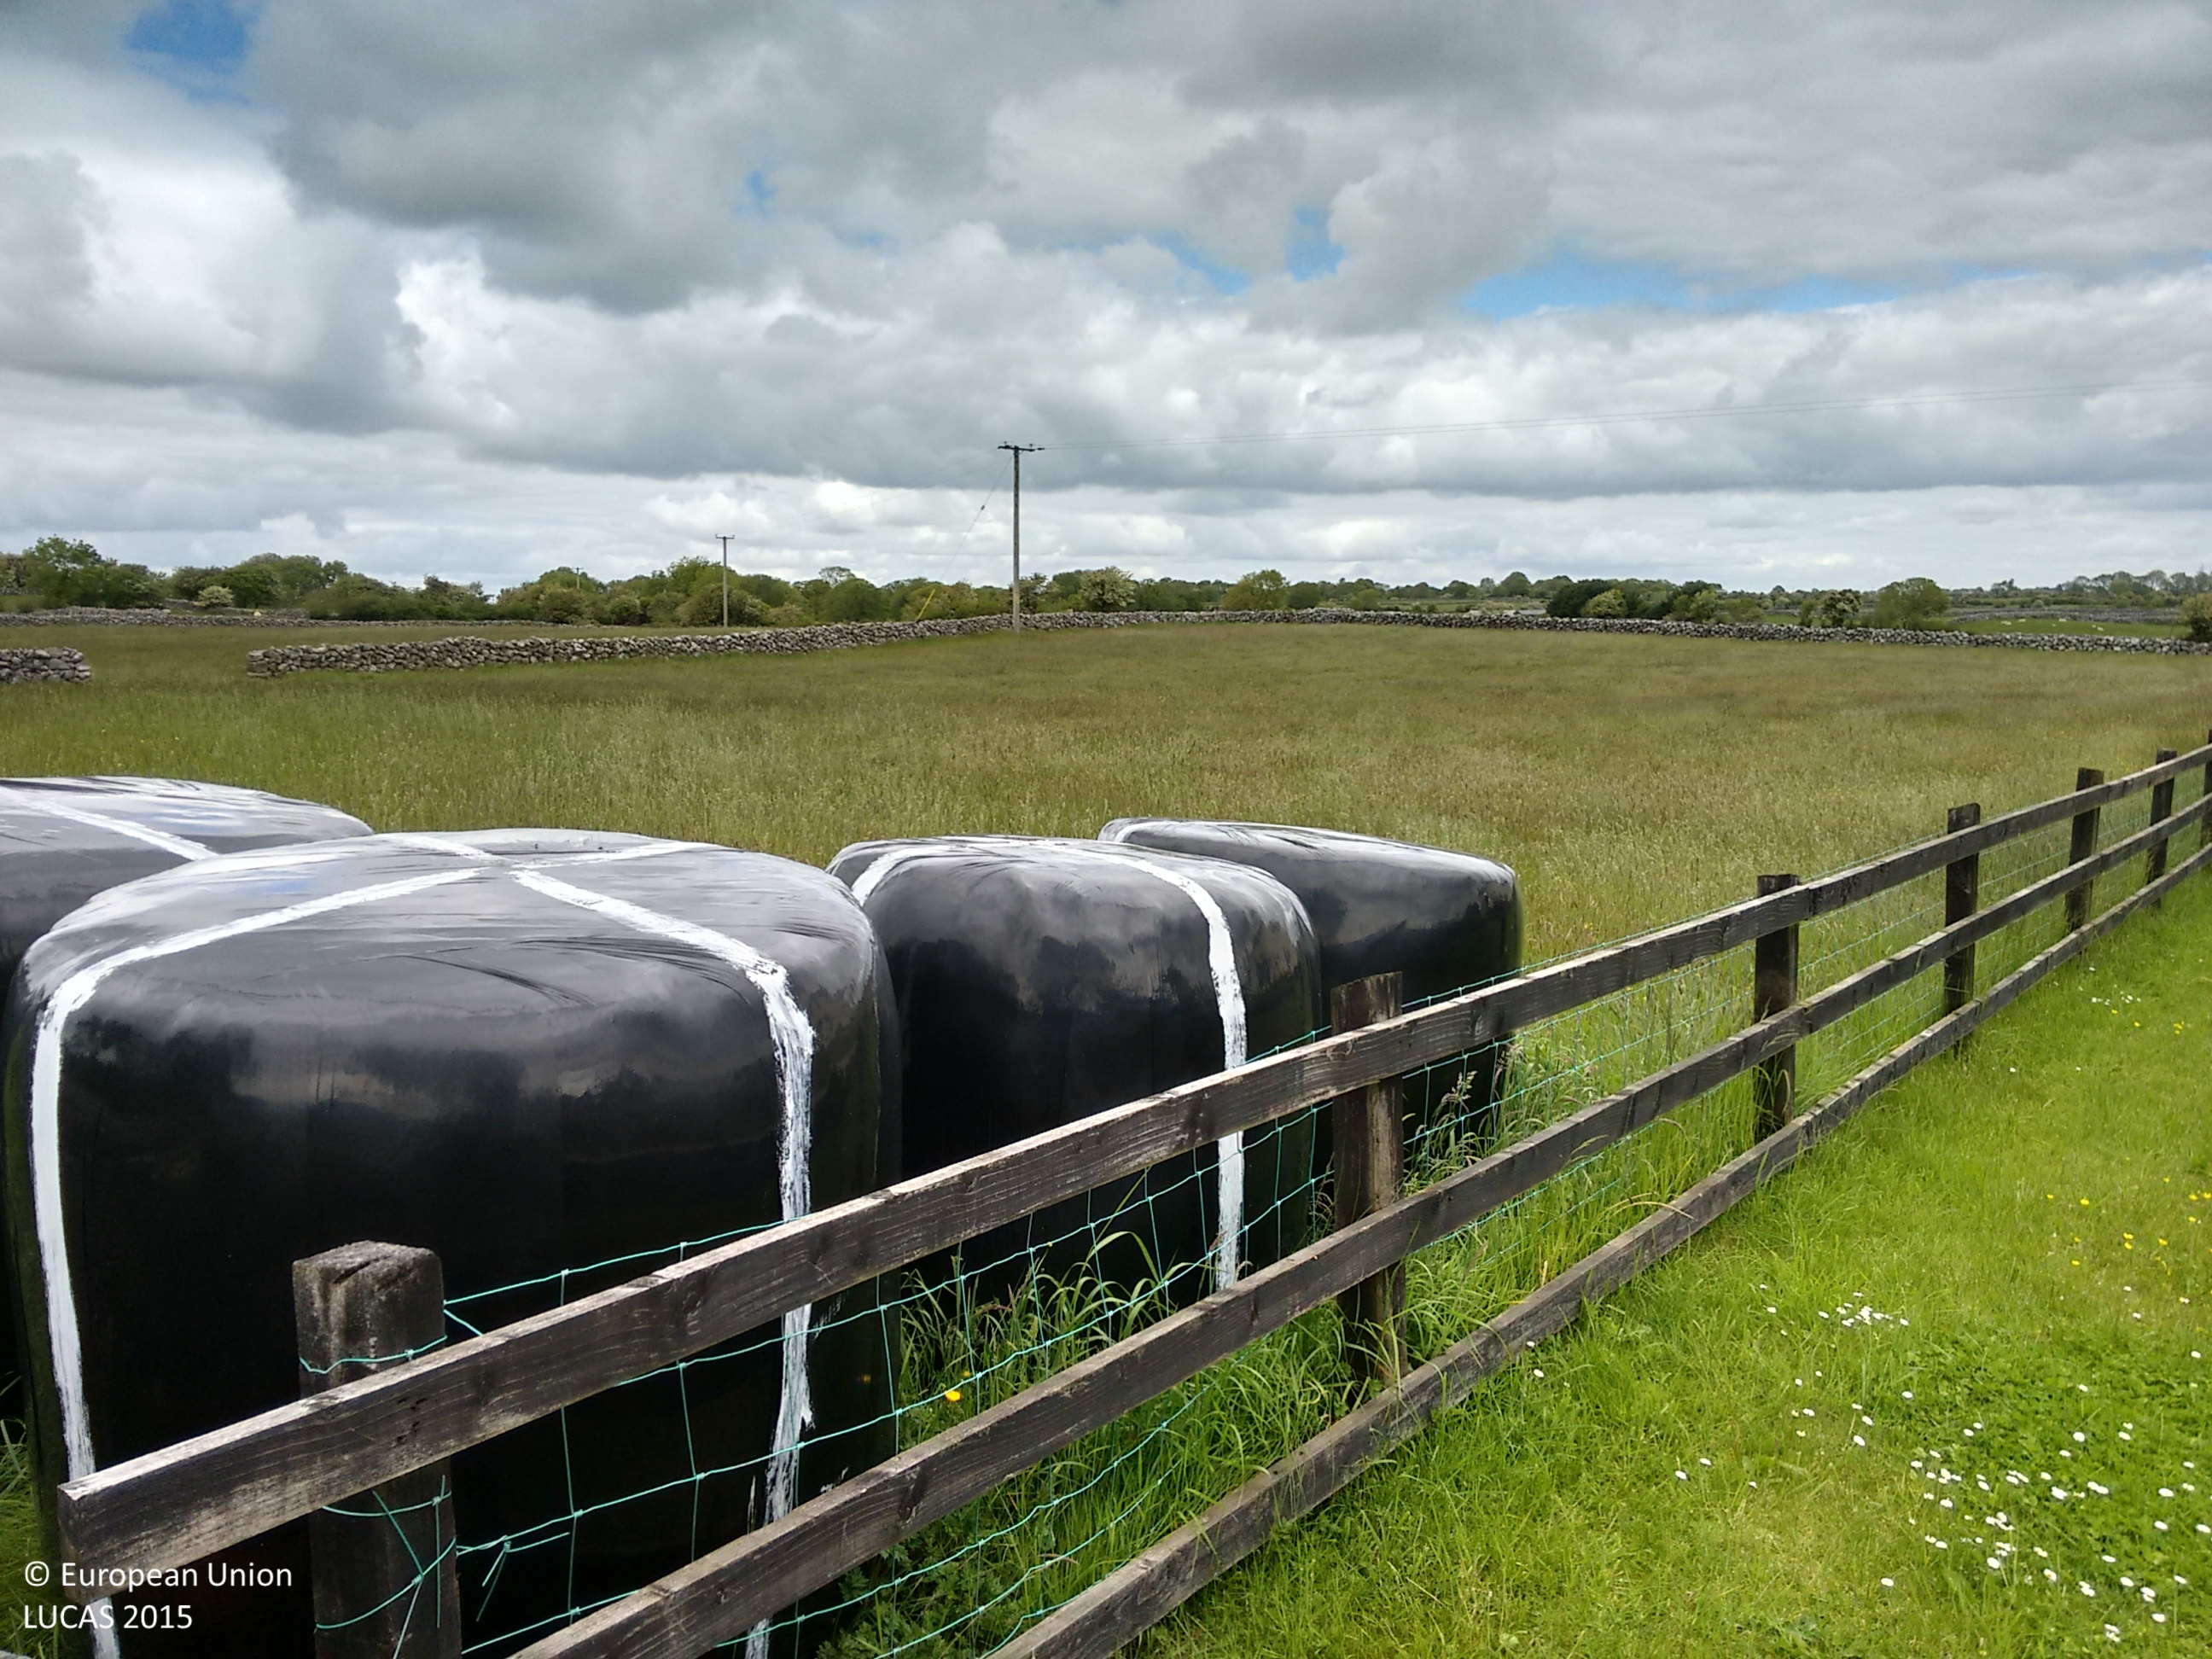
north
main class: Grassland
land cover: Grassland without tree/shrub cover
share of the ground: > 75 %
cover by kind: herbaceous plants 100 %
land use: Agriculture (excluding fallow land and kitchen gardens)
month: June
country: IE
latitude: 53.4594
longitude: -9.0560
